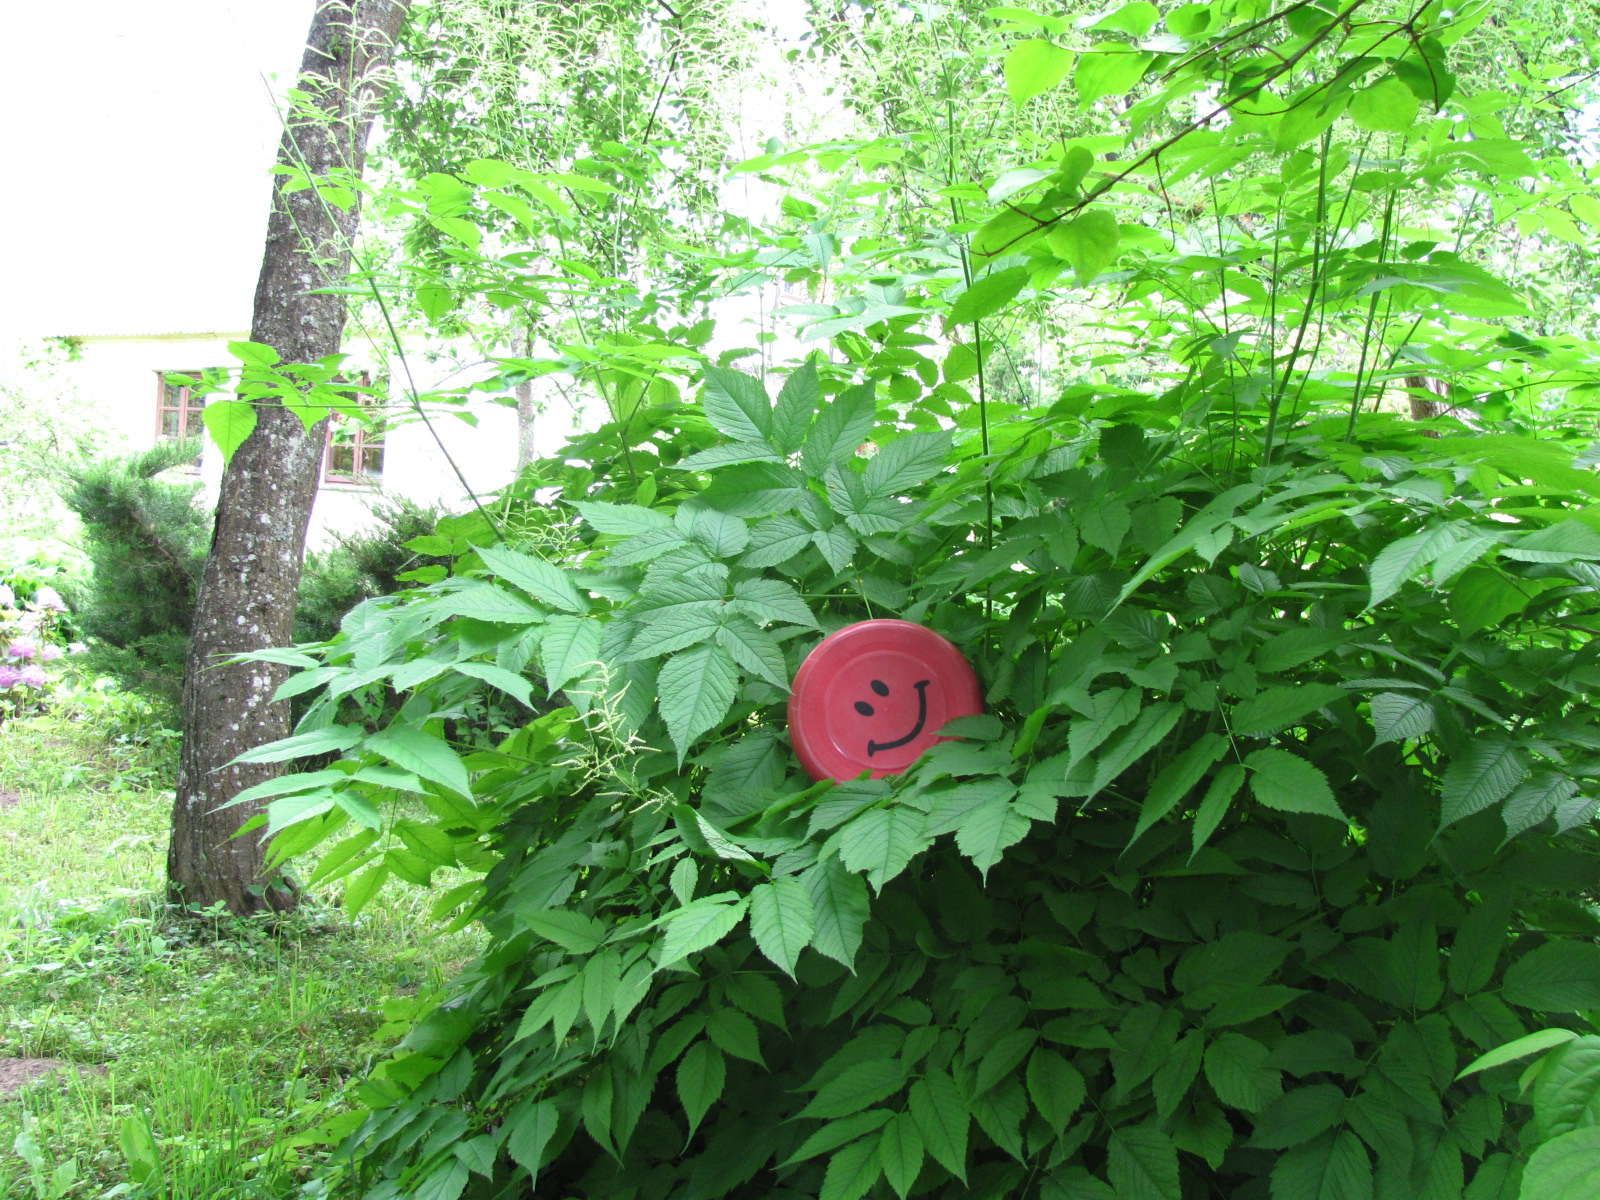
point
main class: Woodland
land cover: Broadleaved woodland
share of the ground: > 75 %
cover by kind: broadleaved forest trees 80 %, herbaceous plants 20 %
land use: Residential
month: June
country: LV
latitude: 56.3562
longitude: 24.0868
